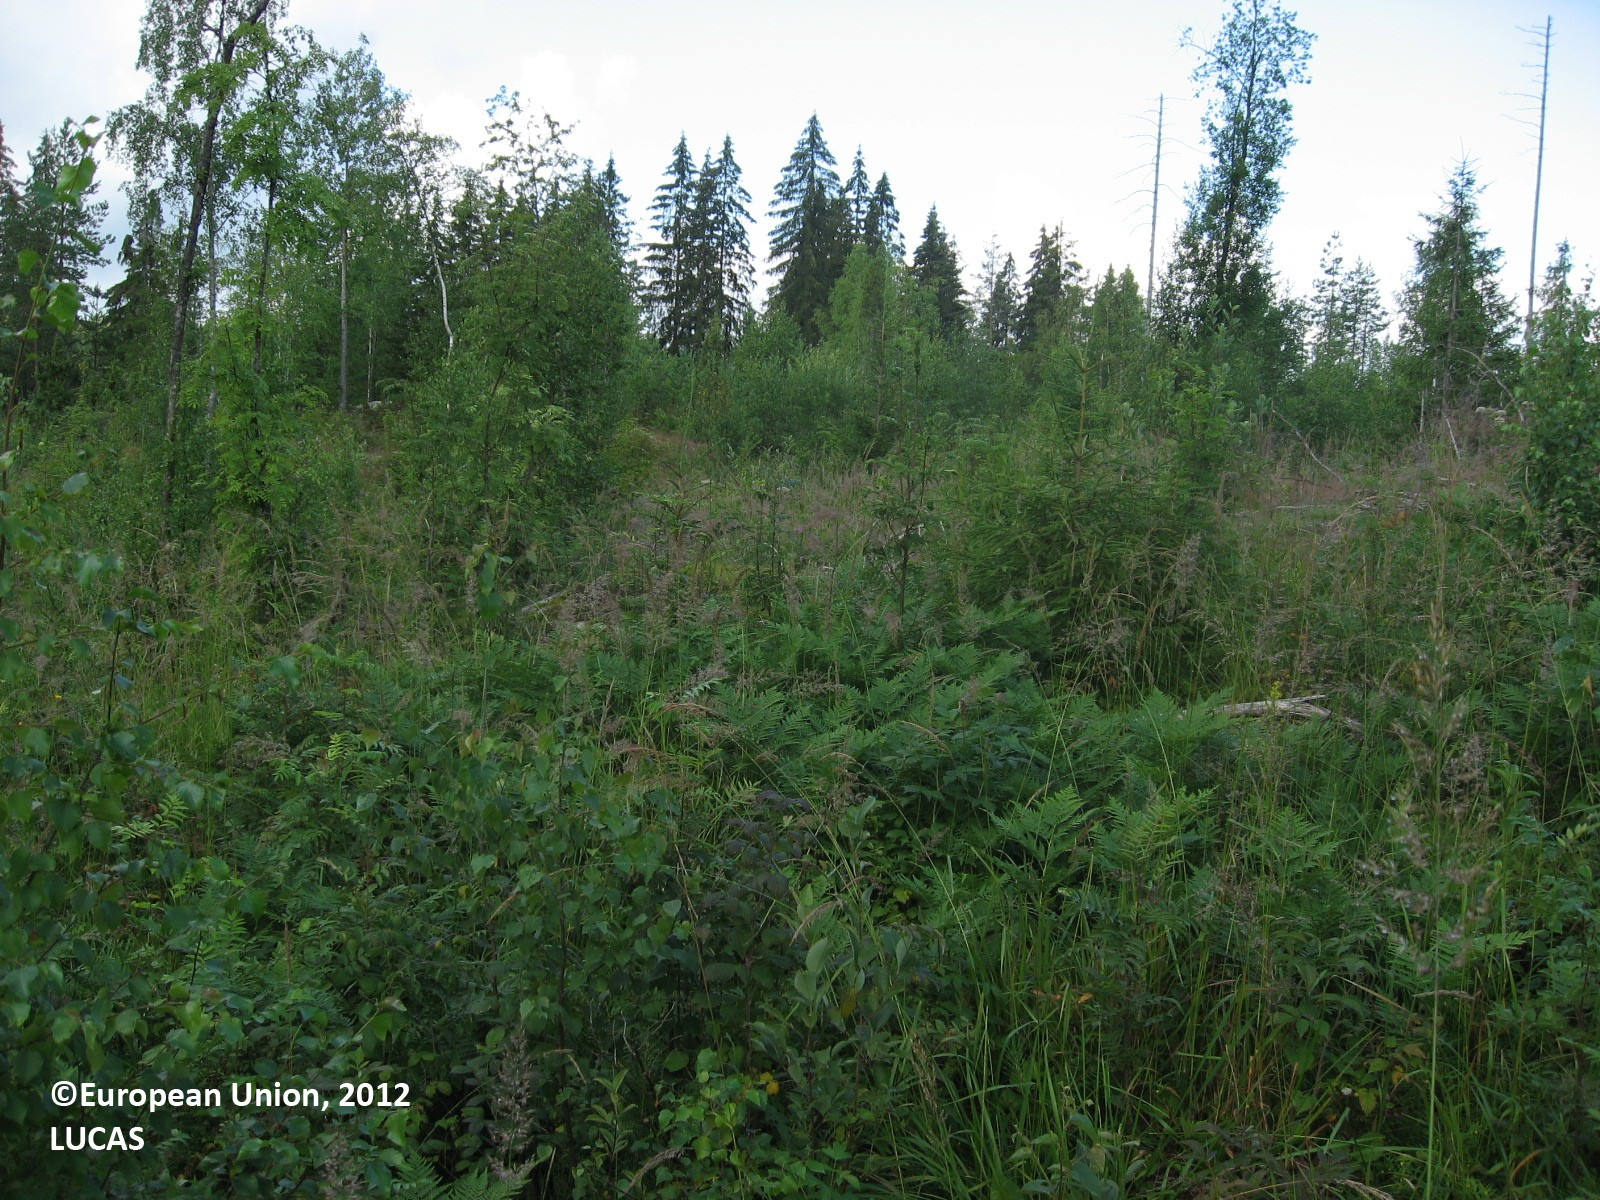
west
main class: Woodland
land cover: Broadleaved woodland
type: boreal forest
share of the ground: 25 - 50 %
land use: Forestry
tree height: < 5 m
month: July
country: FI
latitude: 61.3185
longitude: 25.8778
